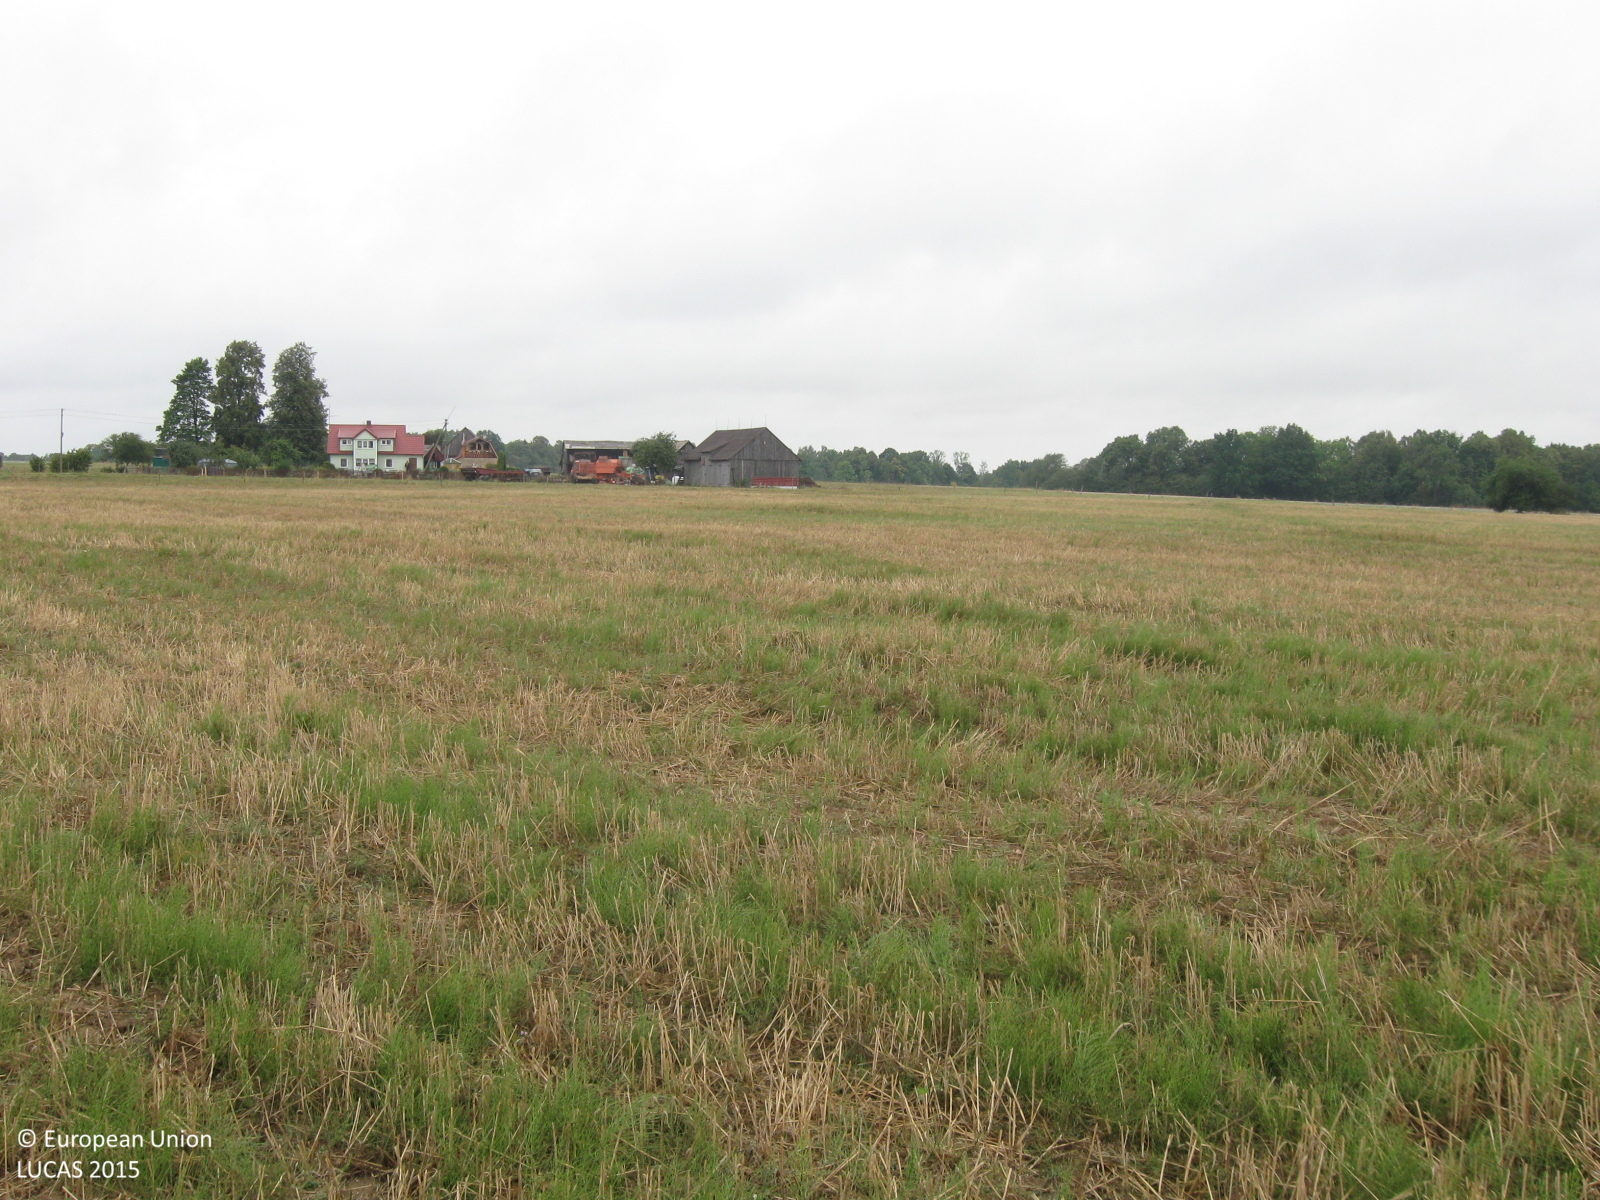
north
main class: Cropland
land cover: Common wheat
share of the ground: > 75 %
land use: Agriculture (excluding fallow land and kitchen gardens)
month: August
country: LT
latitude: 55.3656
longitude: 23.2806
